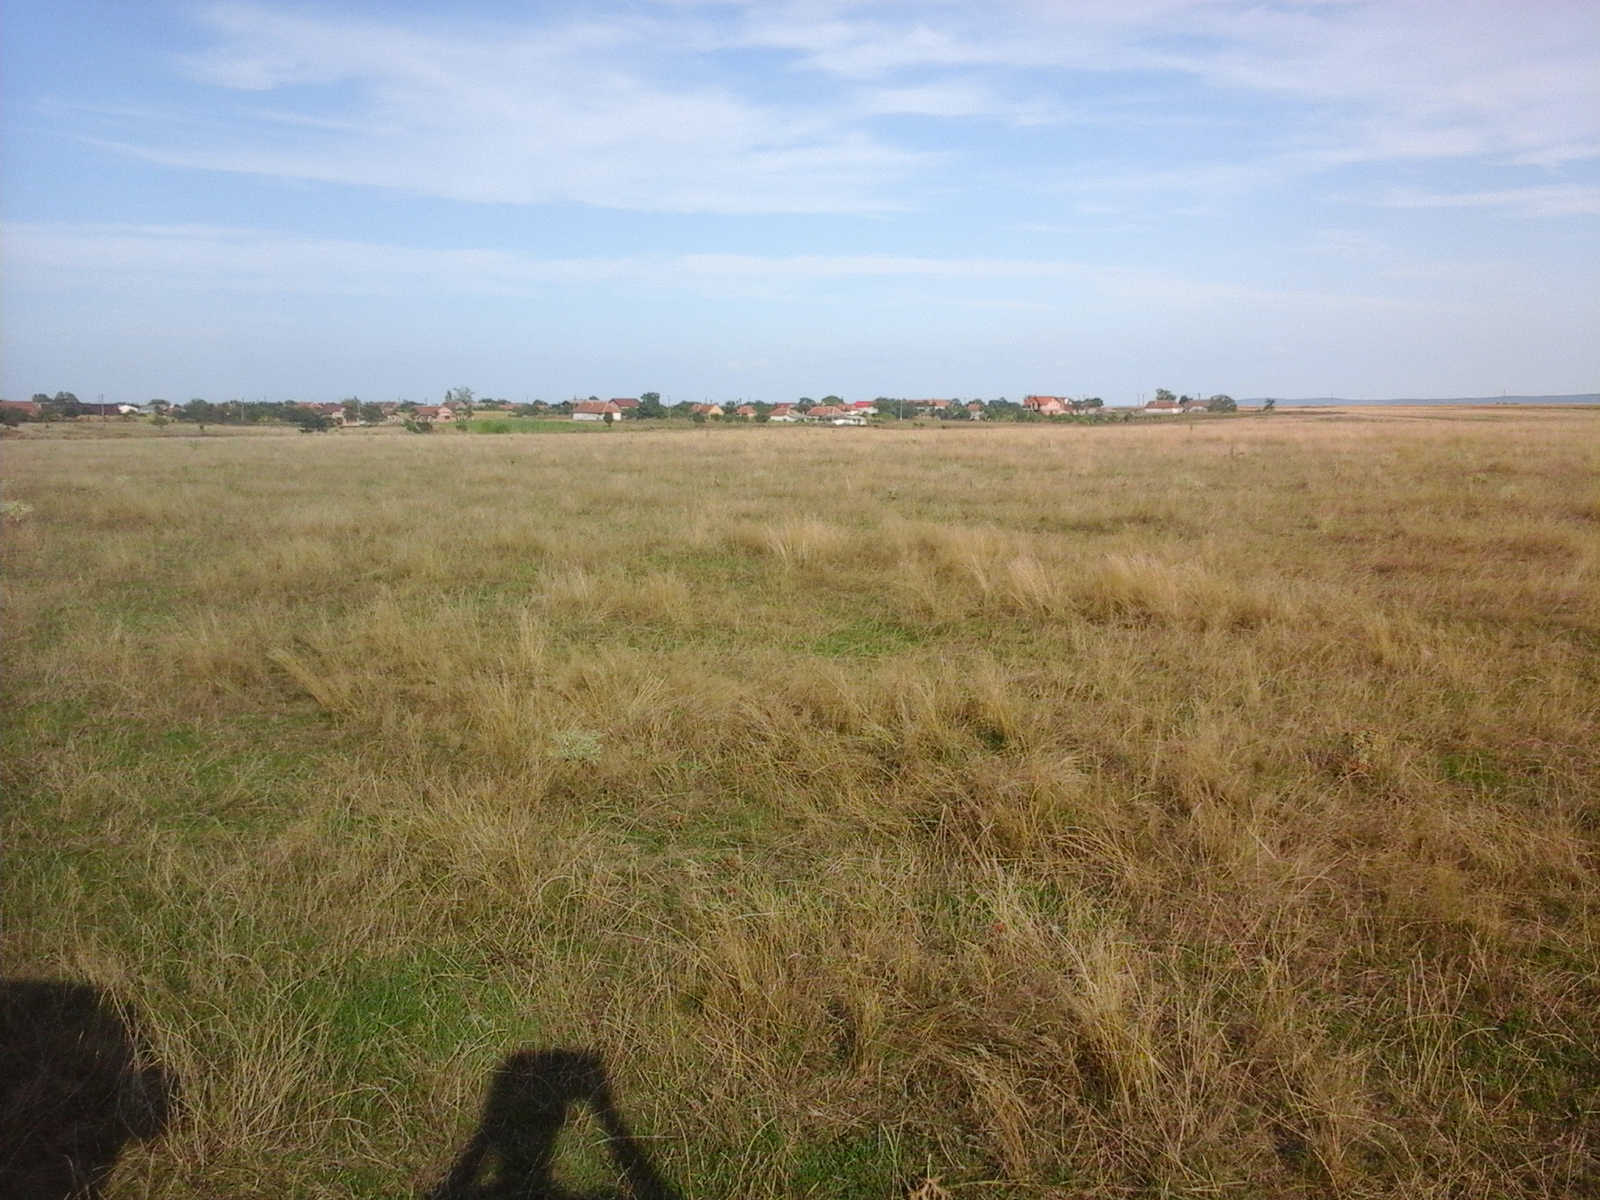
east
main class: Grassland
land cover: Grassland without tree/shrub cover
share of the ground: > 75 %
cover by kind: herbaceous plants 100 %
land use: Agriculture (excluding fallow land and kitchen gardens)
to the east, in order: Grassland without tree/shrub cover
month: August
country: RO
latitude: 46.0165
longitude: 21.3611
